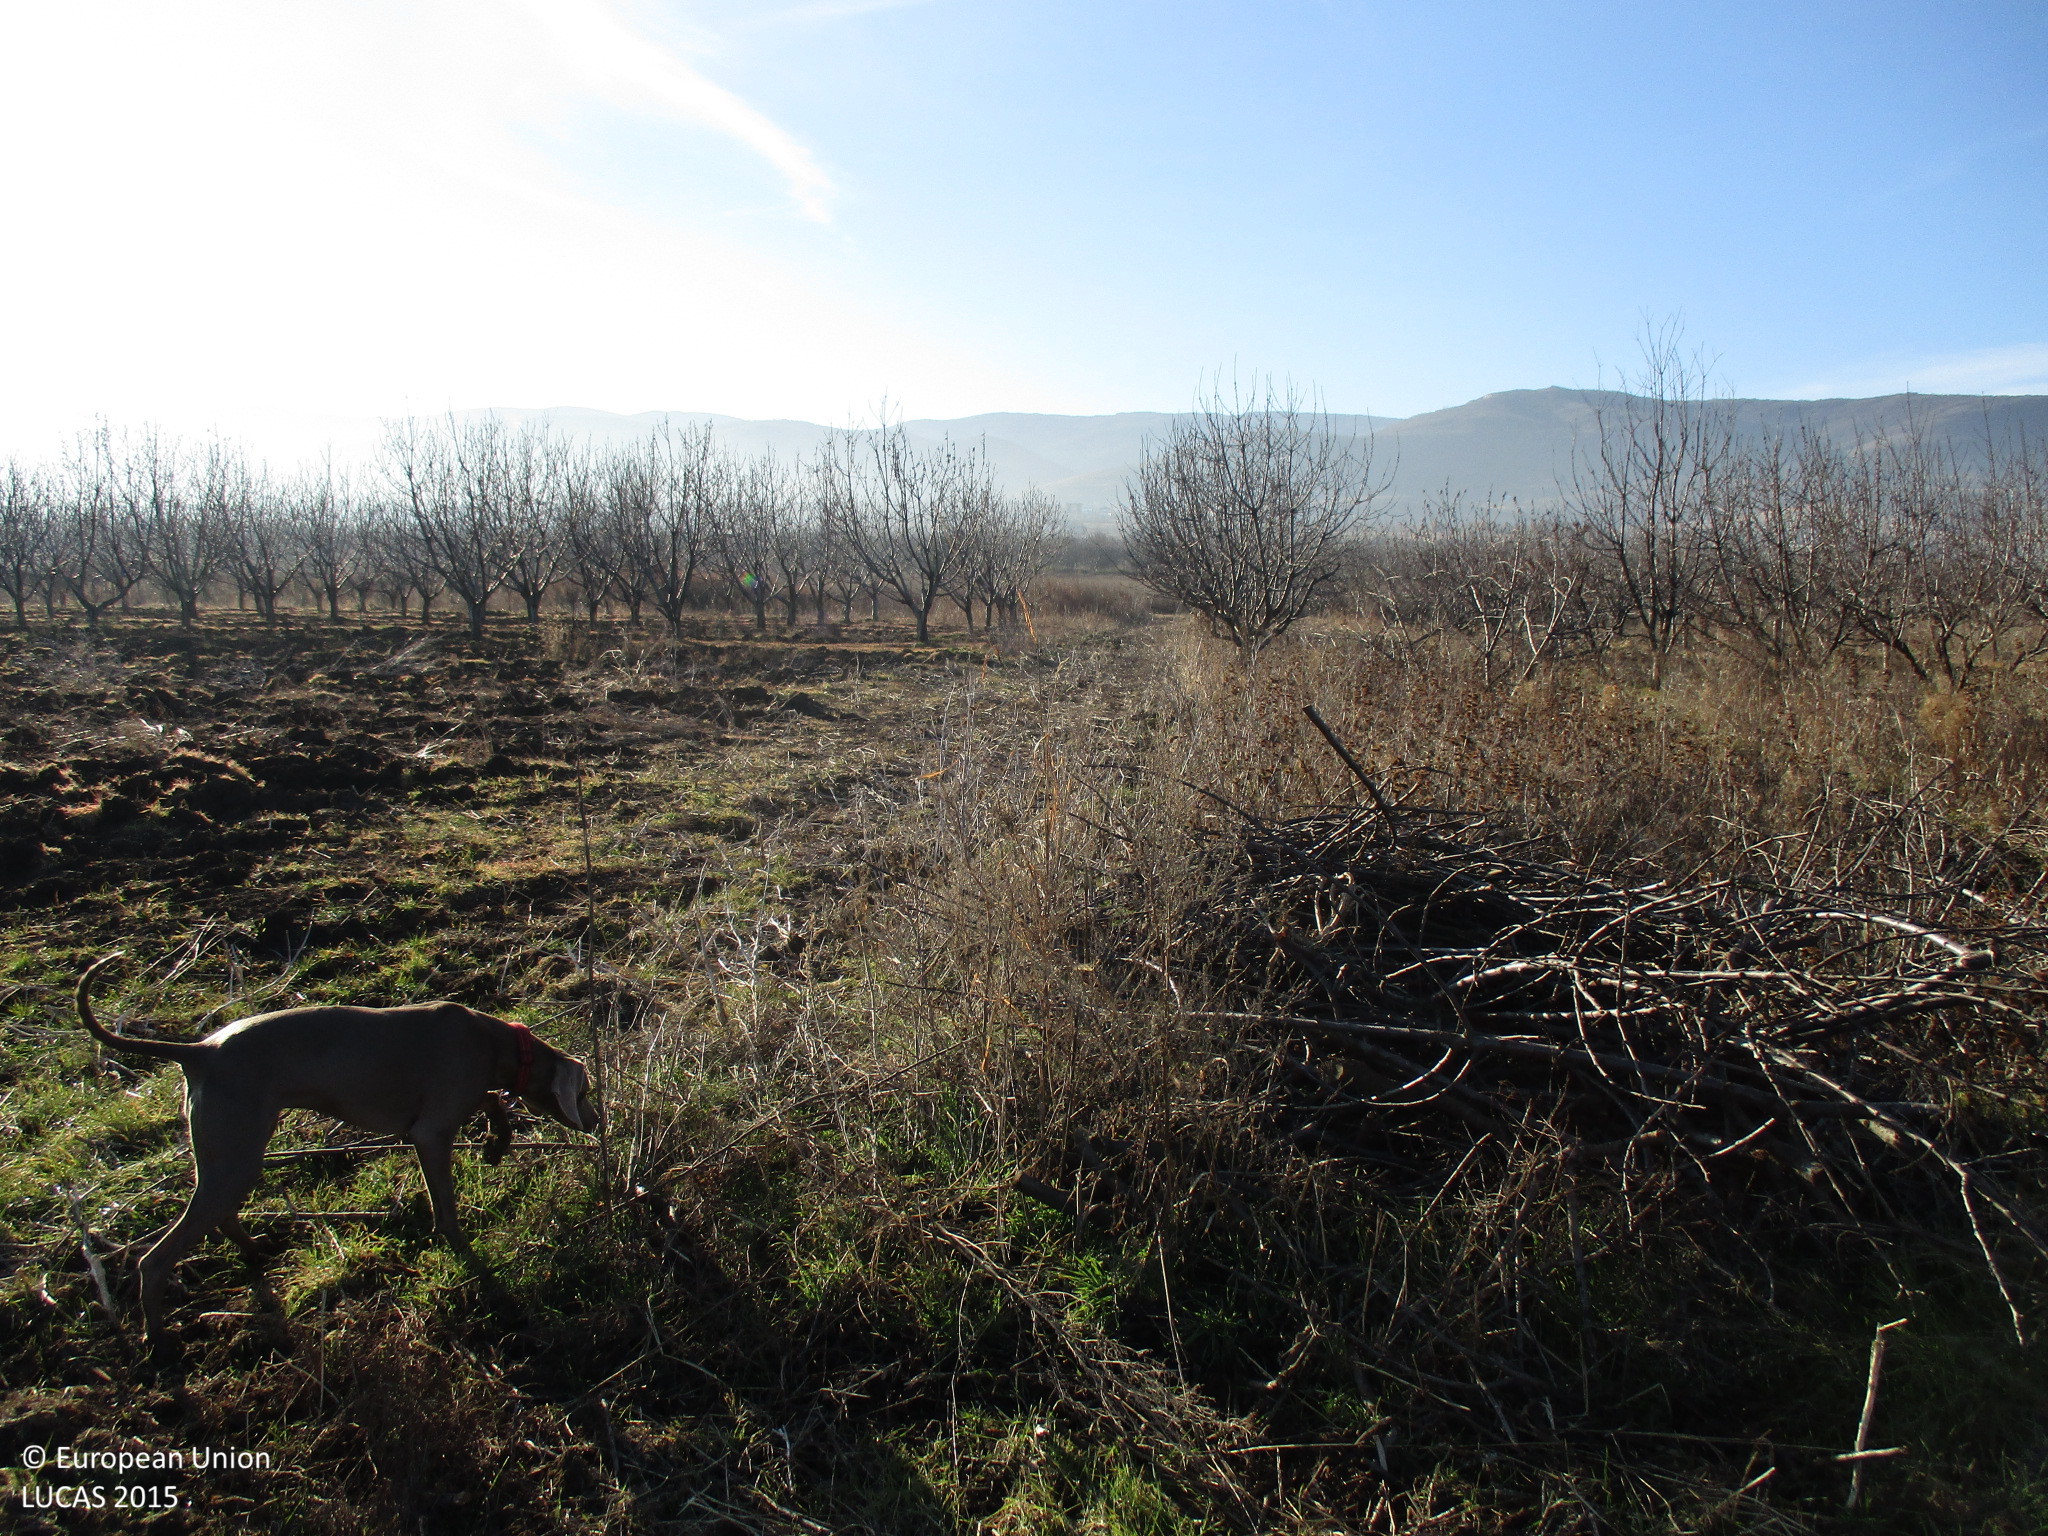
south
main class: Cropland
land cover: Vineyards
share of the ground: 25 - 50 %
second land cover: Spontaneously vegetated surfaces
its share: 25 - 50 %
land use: Agriculture (excluding fallow land and kitchen gardens)
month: December
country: BG
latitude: 42.0823
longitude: 24.7379
